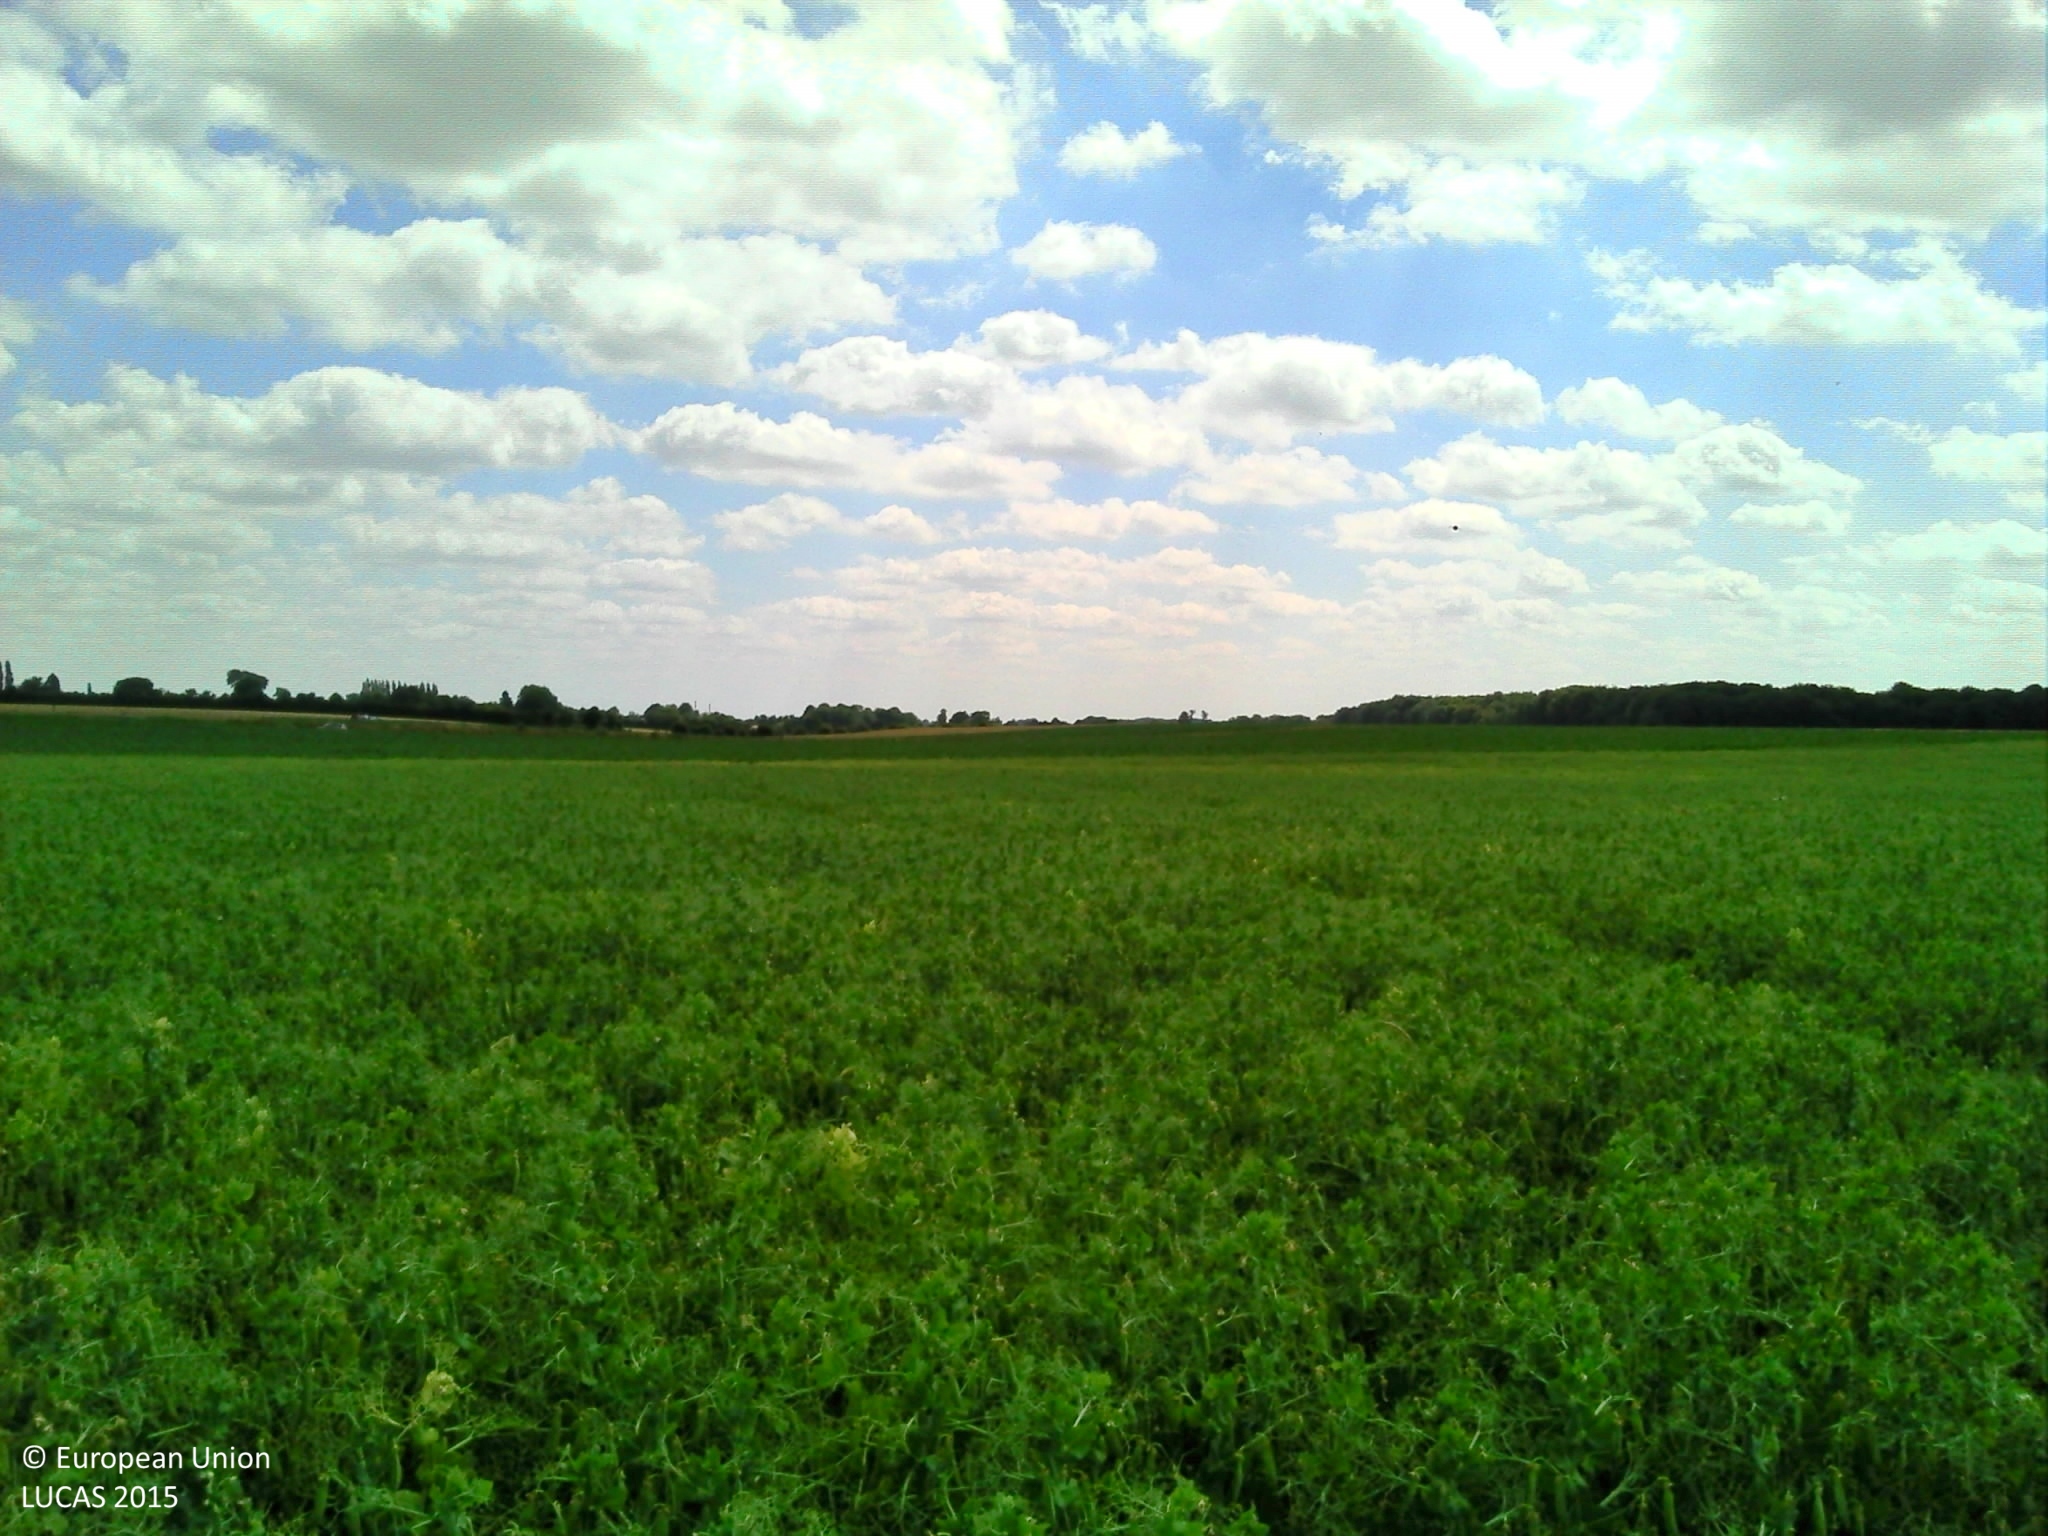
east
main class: Cropland
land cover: Dry pulses
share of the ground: > 75 %
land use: Agriculture (excluding fallow land and kitchen gardens)
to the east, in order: Dry pulses; Grass margins; Maize
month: July
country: FR
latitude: 49.6513
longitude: 1.7697
